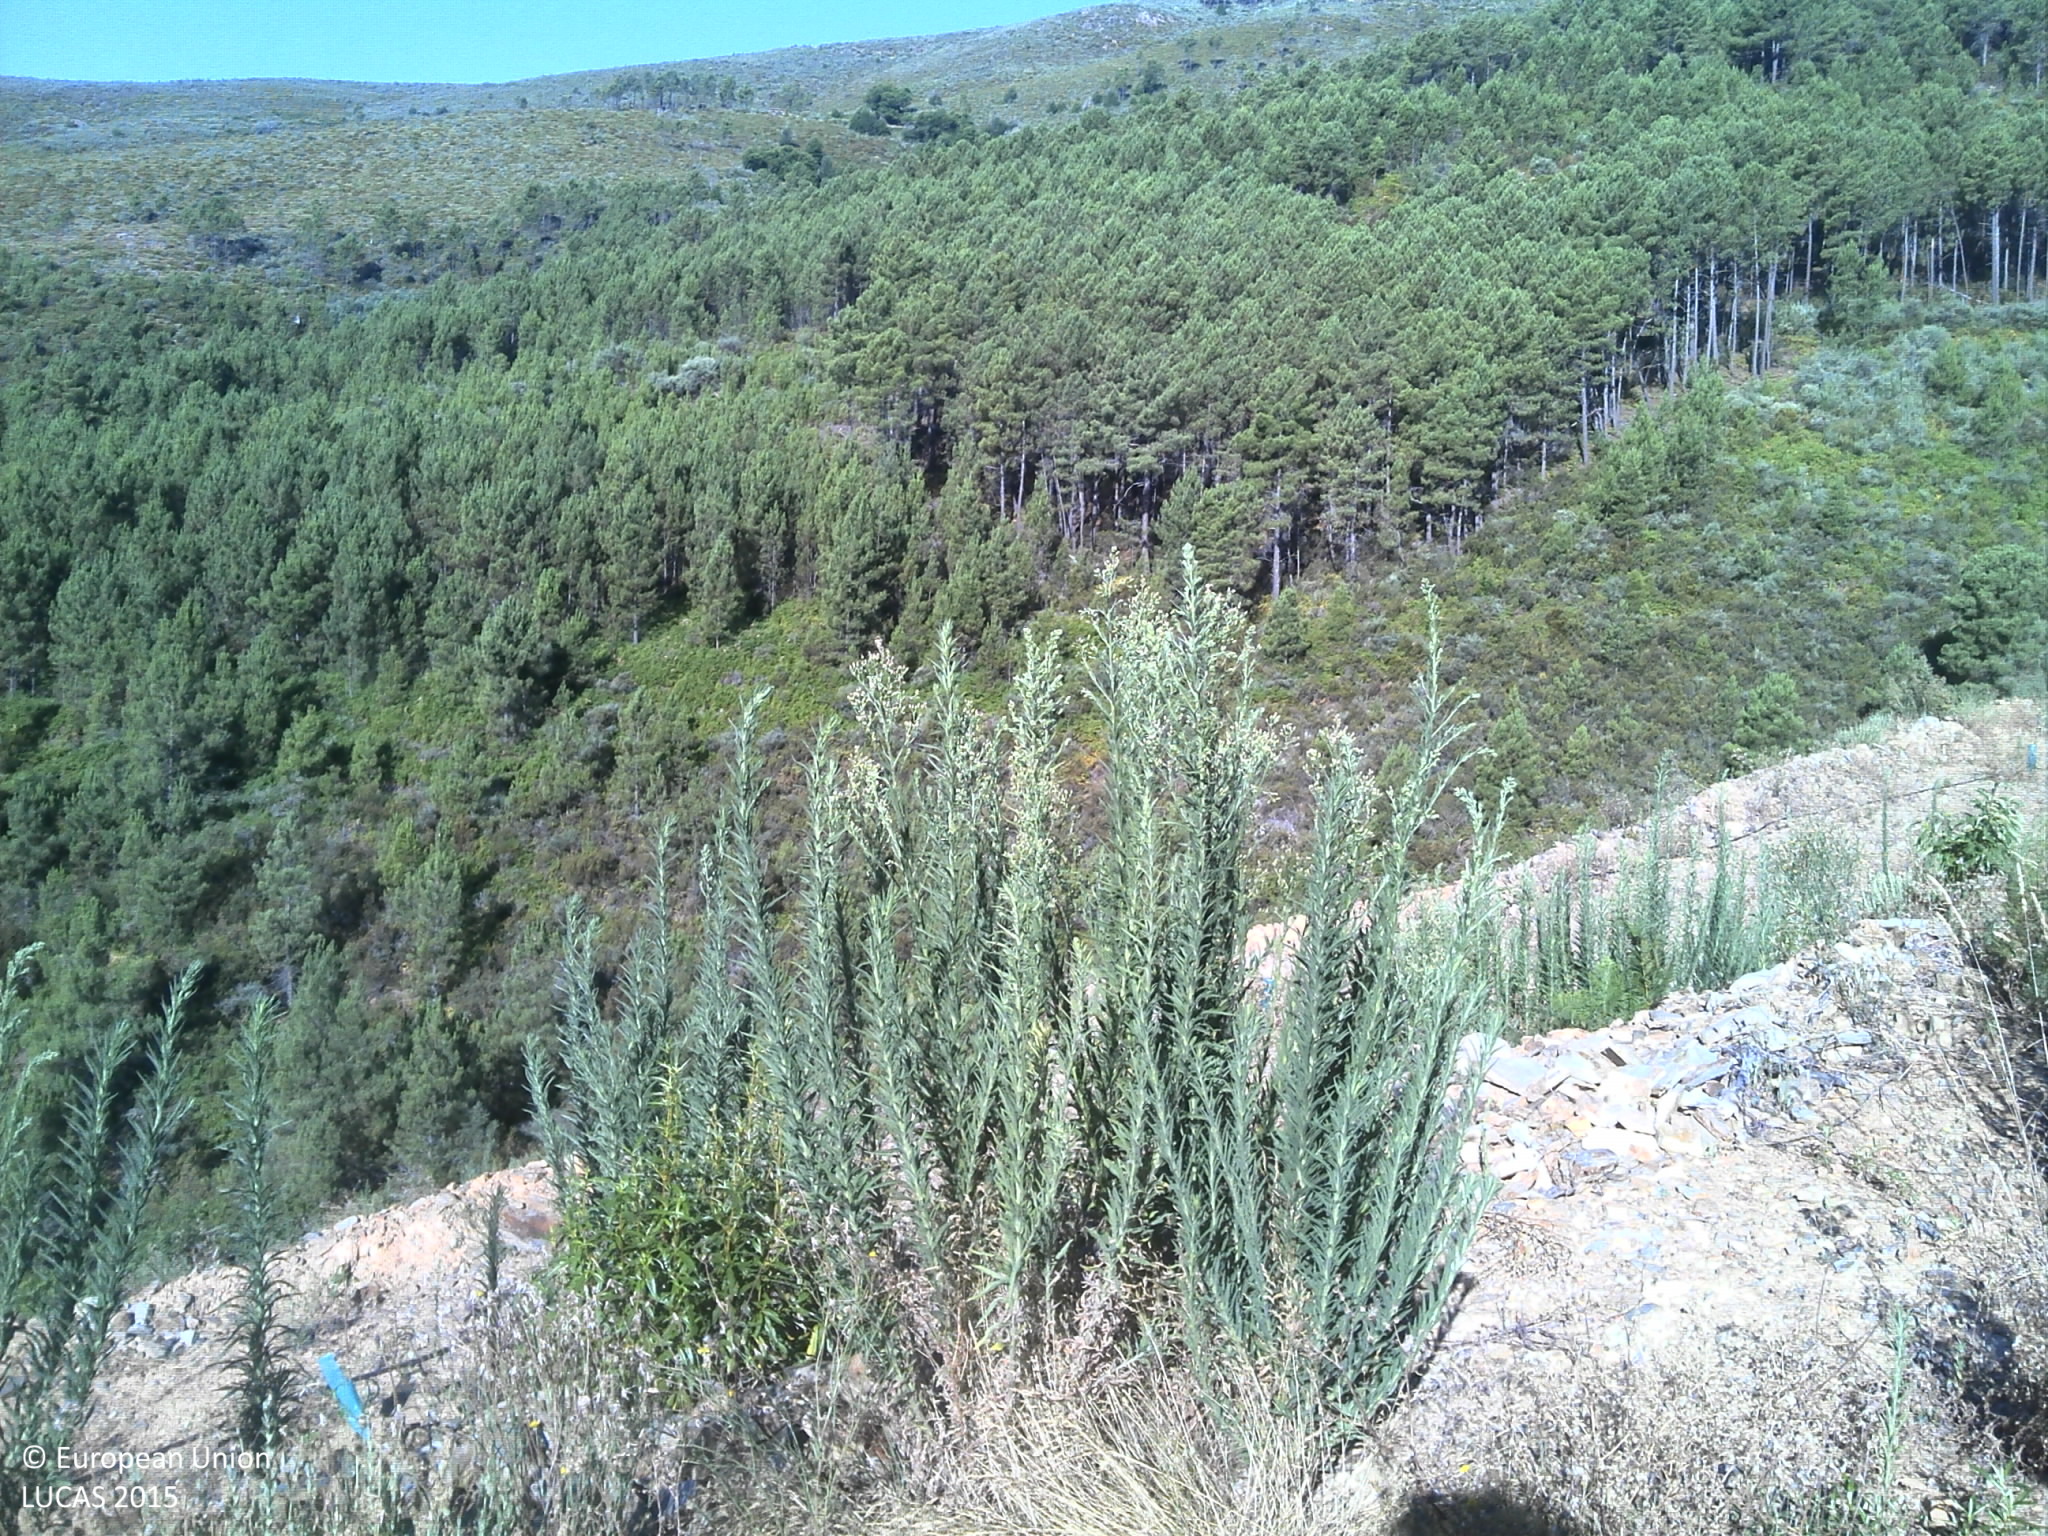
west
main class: Cropland
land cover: Nuts trees
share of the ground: < 10 %
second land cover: Other bare soil
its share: > 75 %
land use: Agriculture (excluding fallow land and kitchen gardens)
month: July
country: PT
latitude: 40.3818
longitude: -7.4827
